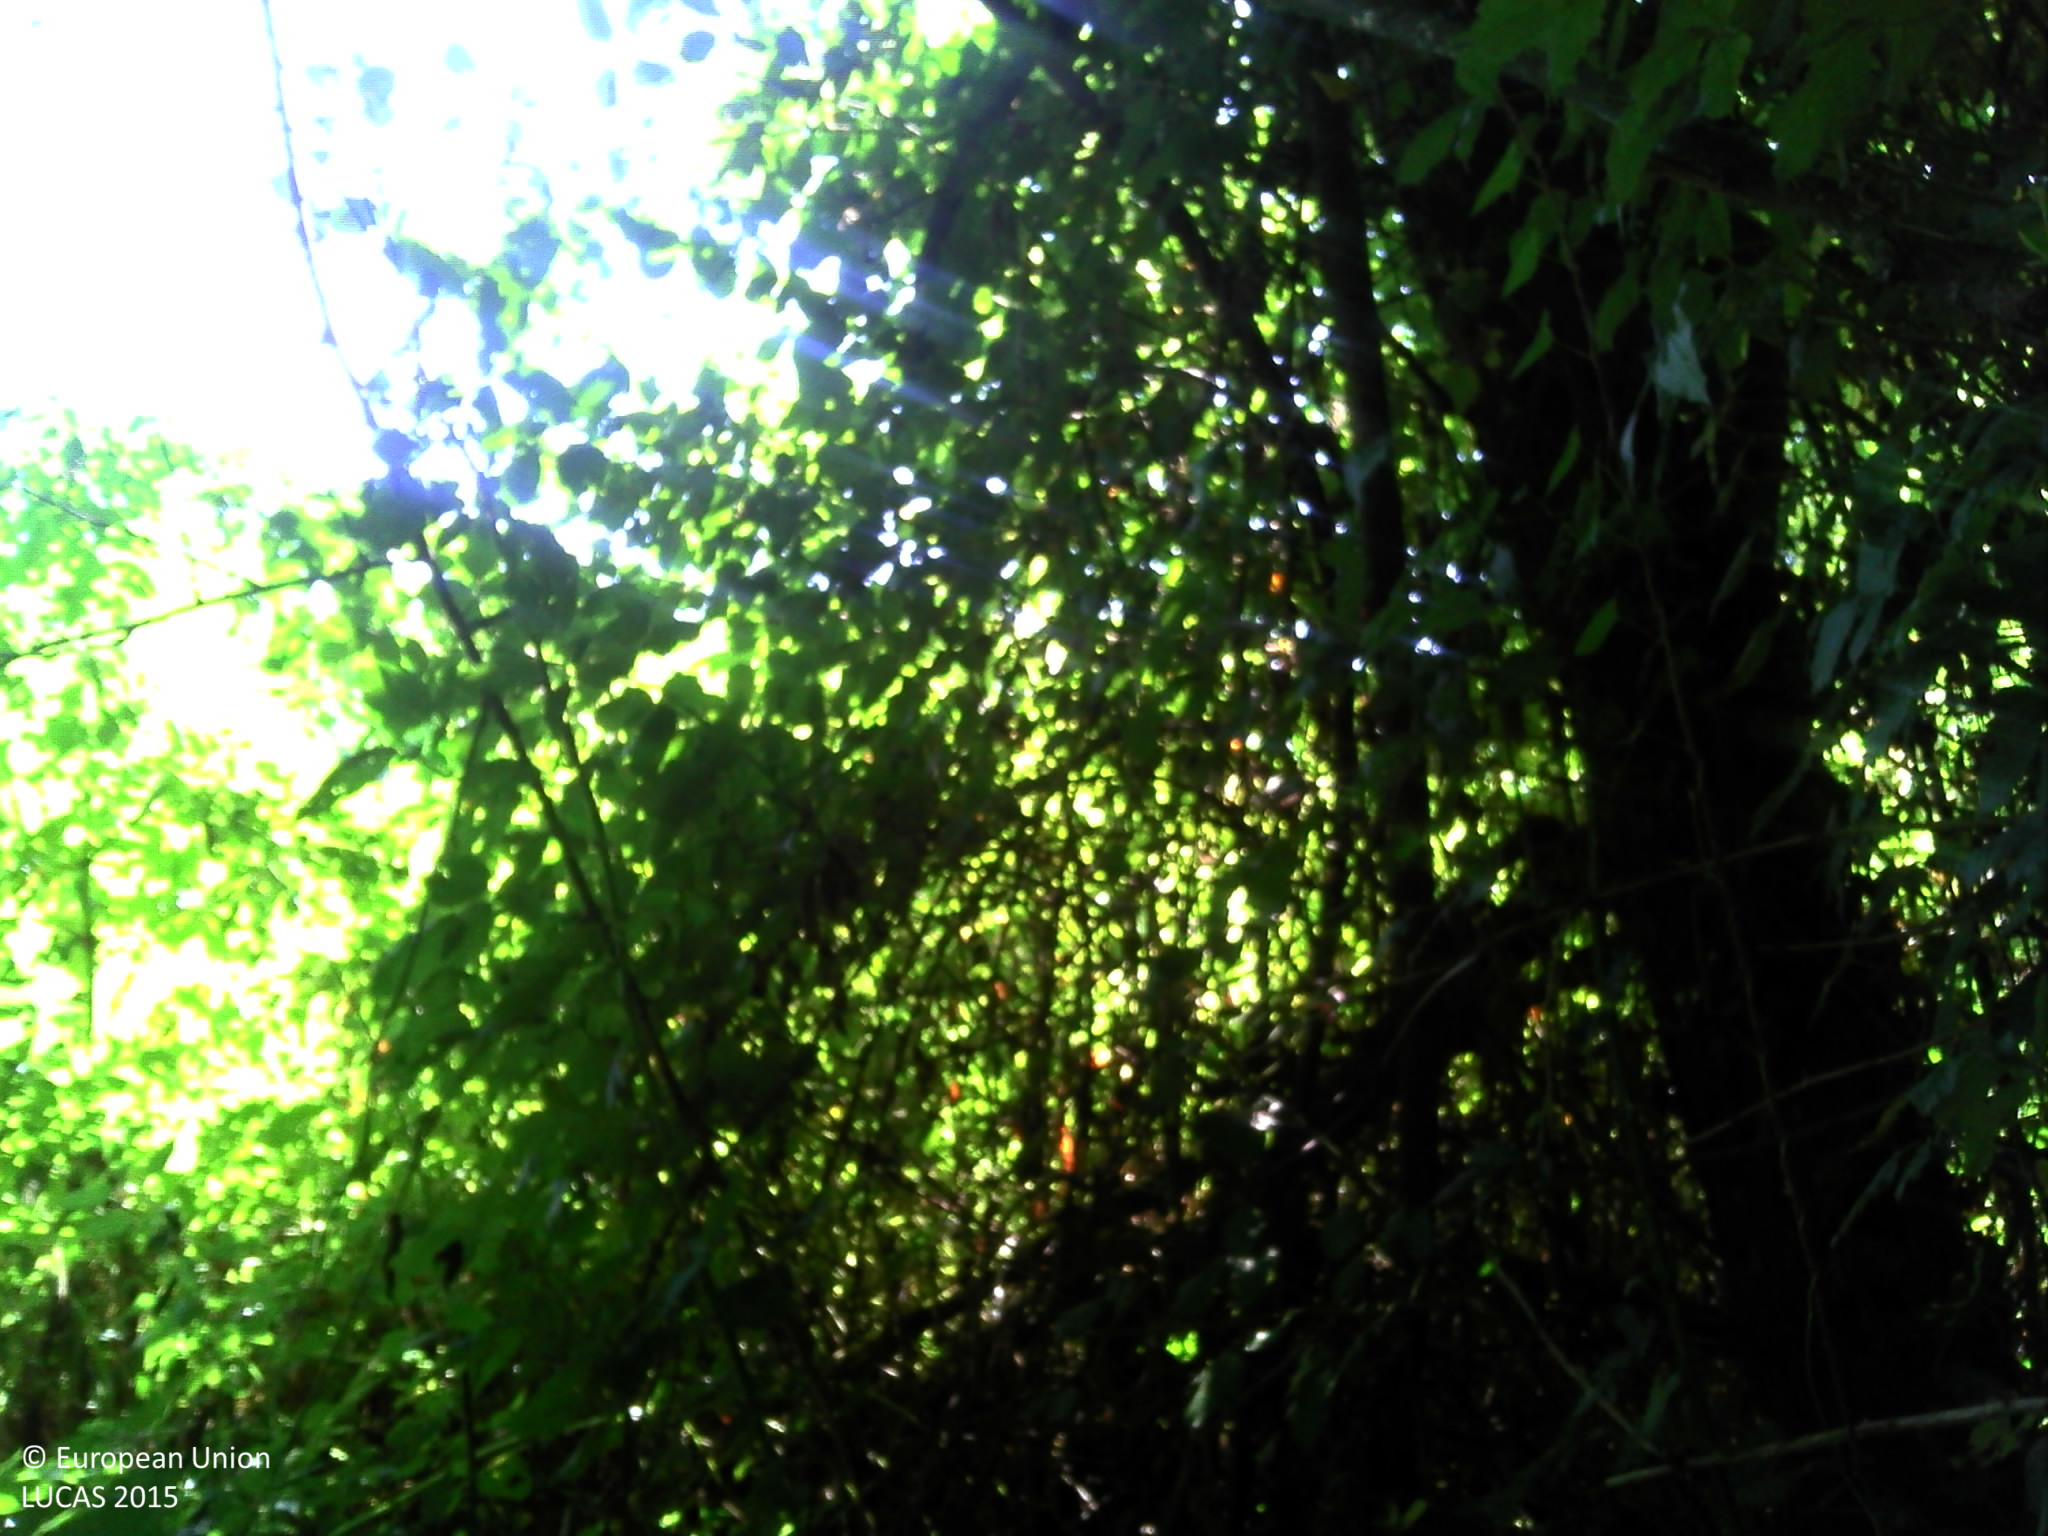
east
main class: Woodland
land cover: Broadleaved woodland
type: thermophilous deciduous forest
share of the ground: > 75 %
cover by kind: broadleaved forest trees 65 %, shrubs 20 %, herbaceous plants 10 %, lichens and mosses 5 %
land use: Forestry
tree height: > 5 m
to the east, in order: Broadleaved woodland; Shruby margins; Maize; Grass margins; Fences; Grass margins; Maize
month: August
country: FR
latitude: 43.4771
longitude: -1.1289
